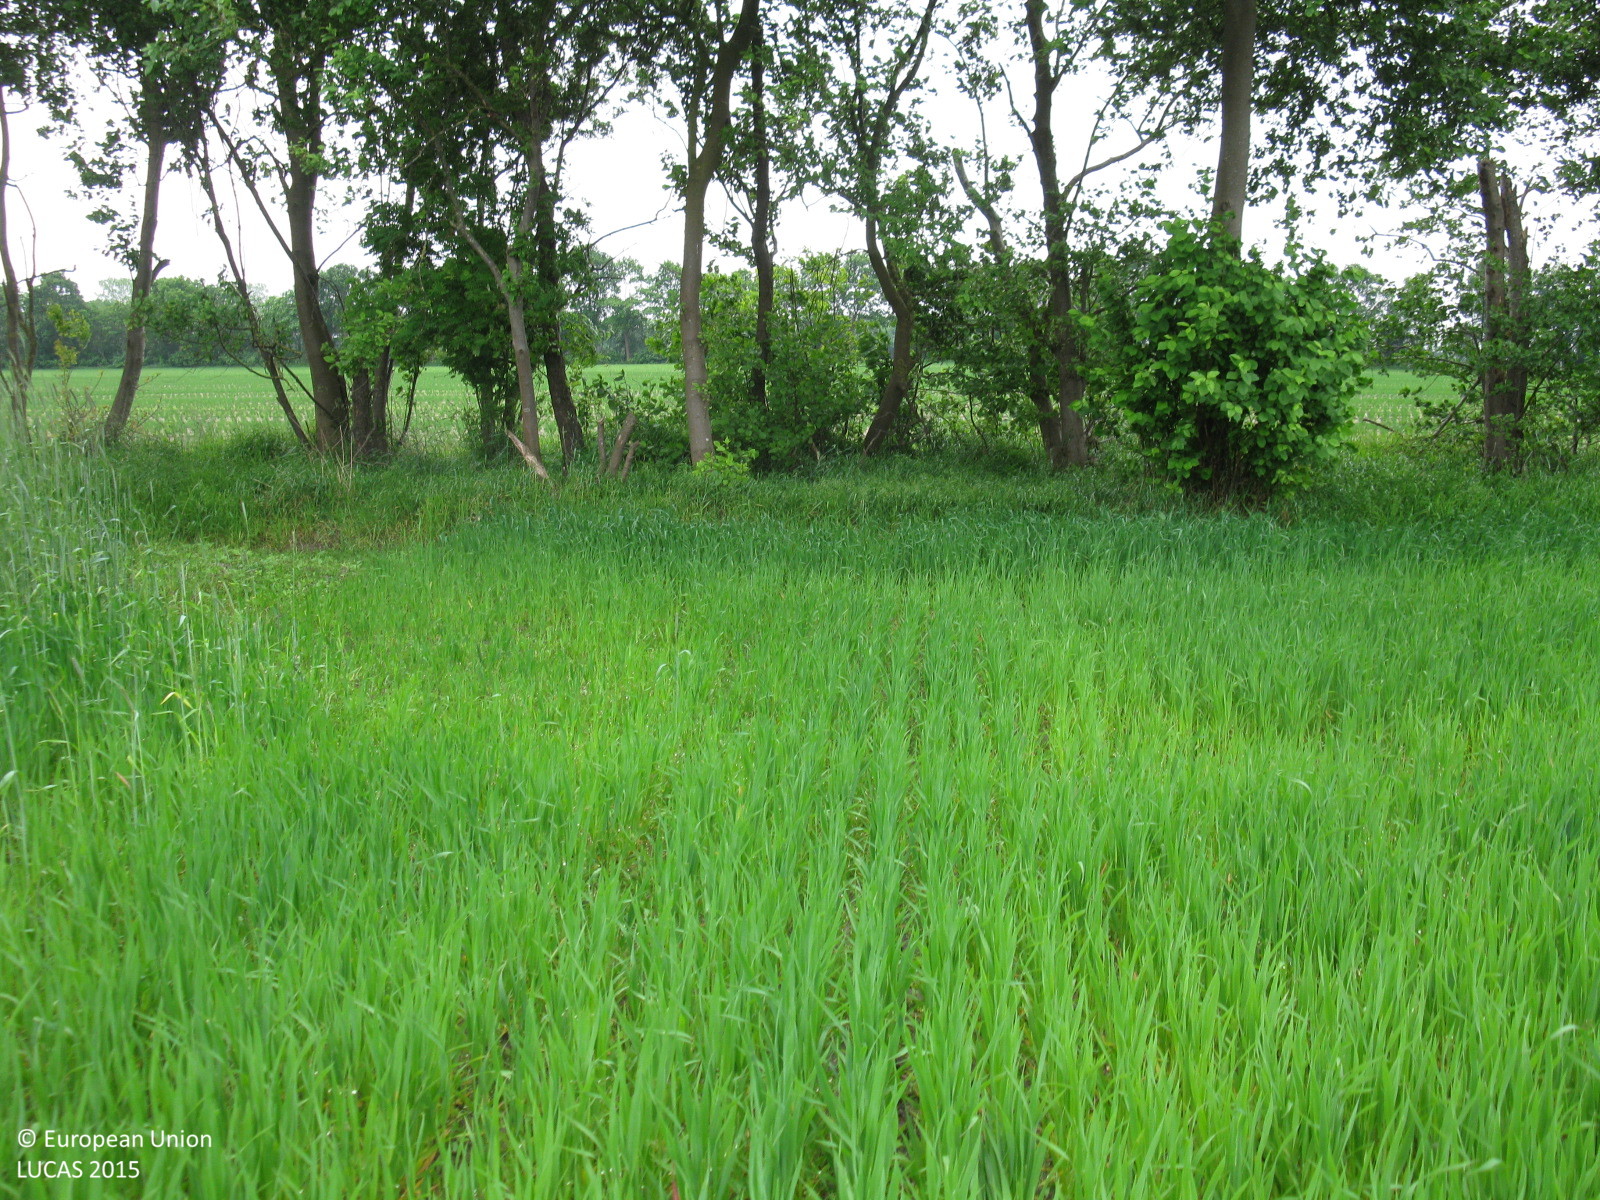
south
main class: Cropland
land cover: Oats
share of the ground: > 75 %
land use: Agriculture (excluding fallow land and kitchen gardens)
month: June
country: DE
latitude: 53.0322
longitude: 7.3910
